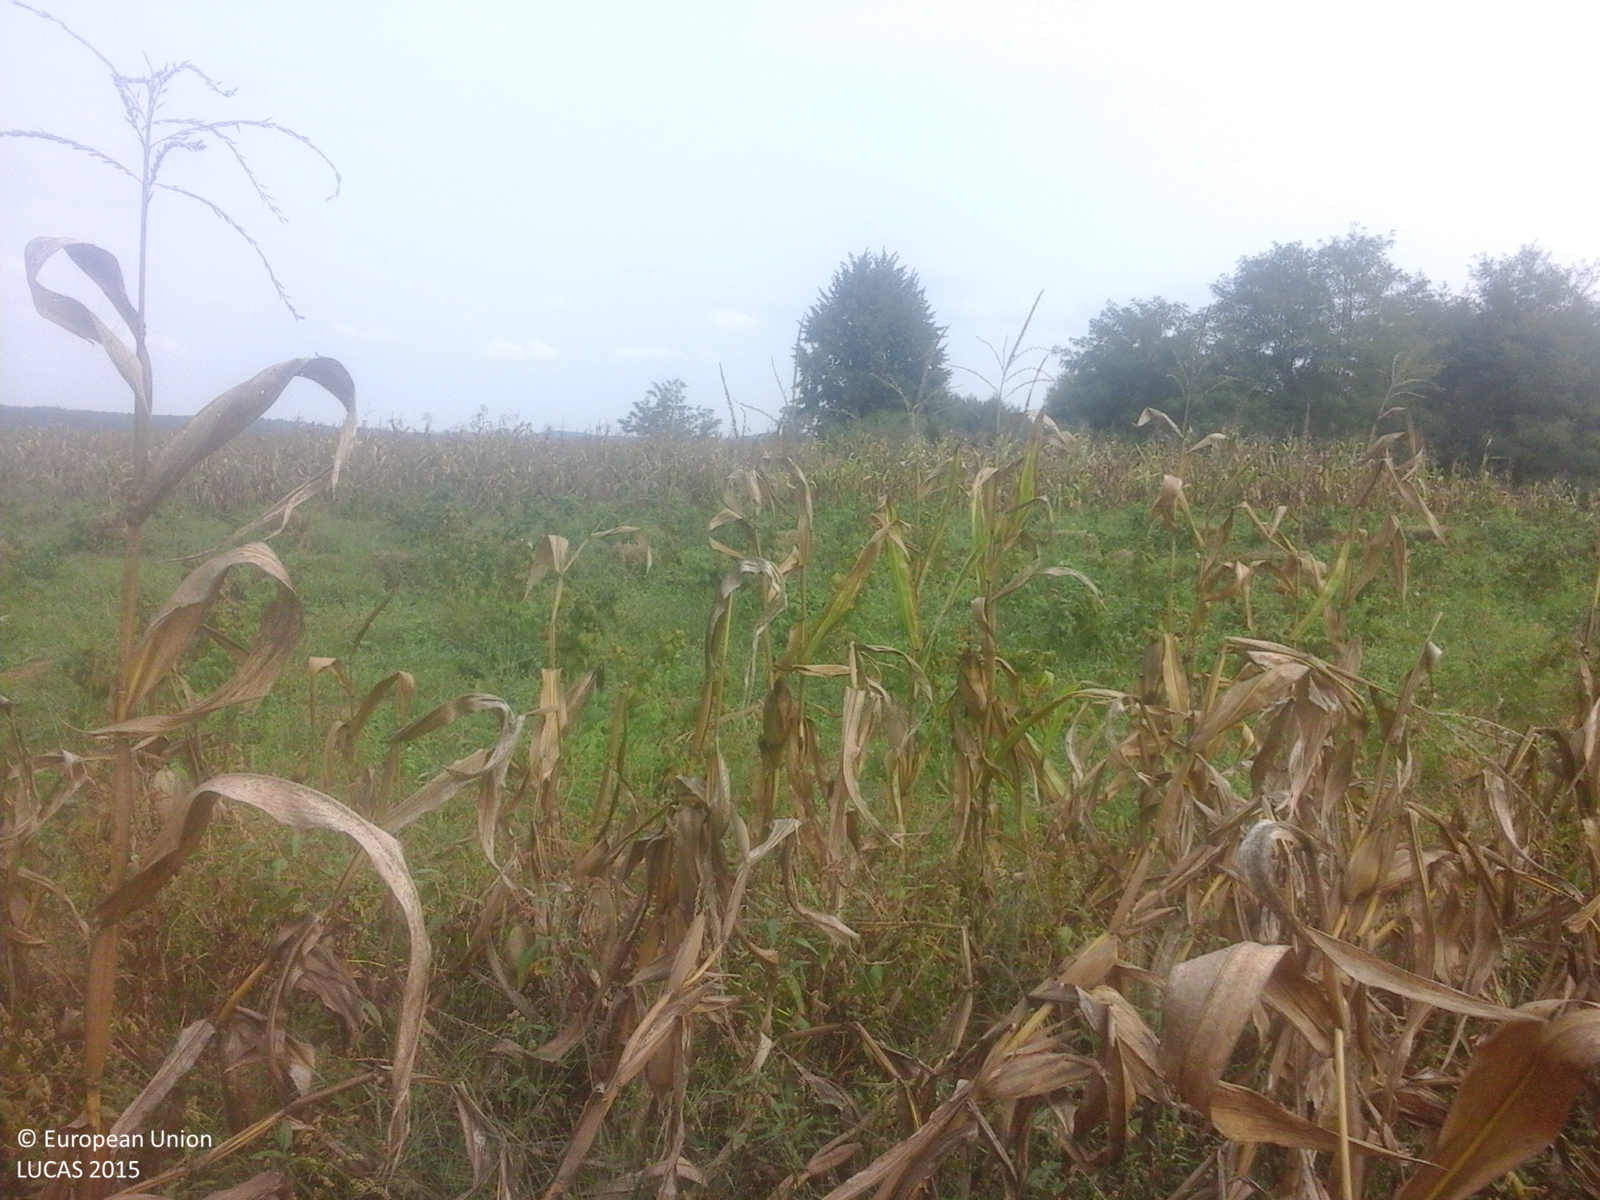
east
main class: Cropland
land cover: Maize
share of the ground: > 75 %
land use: Agriculture (excluding fallow land and kitchen gardens)
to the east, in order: Maize; Other fresh vegetables; Tracks; Other fresh vegetables; Maize; Lucerne; Other fresh vegetables; Grass margins; Paved roads, cycling and walking lanes; Grassland without tree/shrub cover; Single bushes/trees; Other fresh vegetables; Other bare soil; Maize; Grass margins; Tracks; Spontaneously vegetated surfaces; Tracks; Grassland without tree/shrub cover; Tracks; Grassland without tree/shrub cover
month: September
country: RO
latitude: 45.8665
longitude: 22.2167
